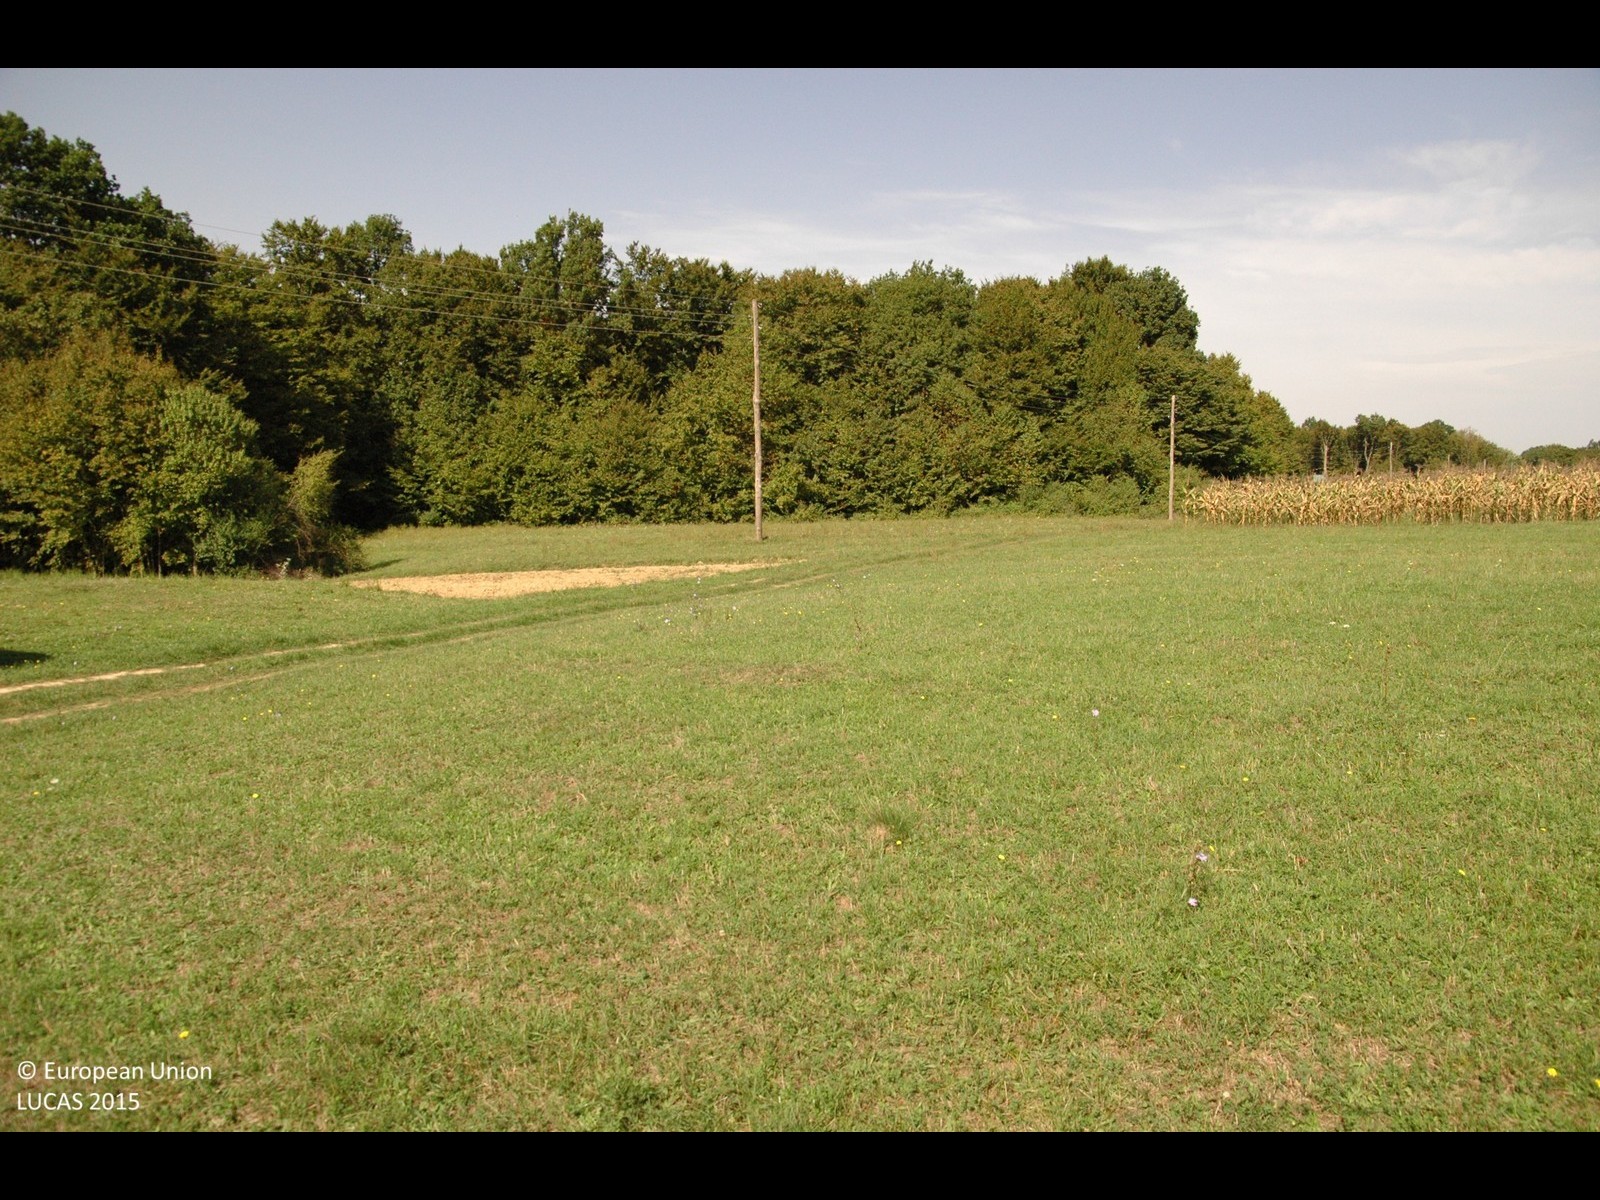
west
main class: Grassland
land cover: Grassland without tree/shrub cover
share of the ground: > 75 %
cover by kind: herbaceous plants 100 %
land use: Agriculture (excluding fallow land and kitchen gardens)
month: September
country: HR
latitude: 45.5560
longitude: 15.9026
